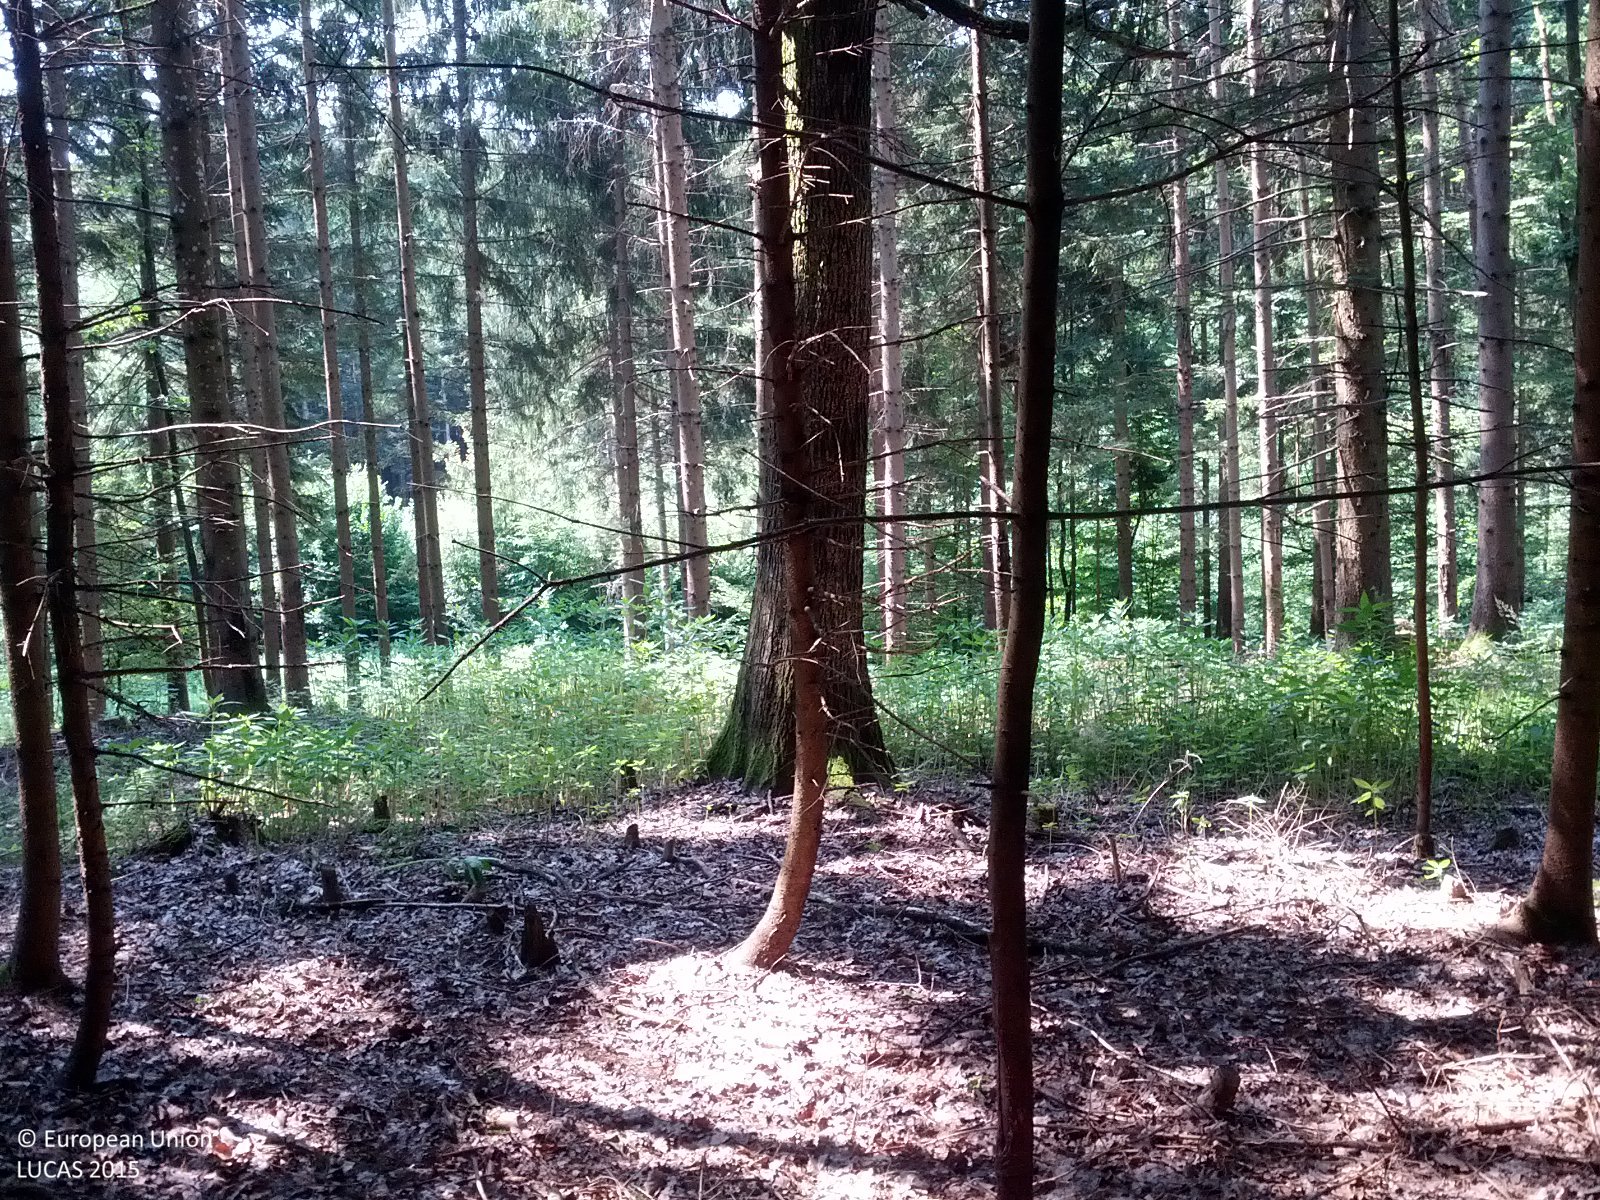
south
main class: Woodland
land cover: Spruce dominated coniferous woodland
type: hemiboreal forest and nemoral coniferous forest and mixed broadleaved-coniferous forest
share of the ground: > 75 %
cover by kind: coniferous forest trees 90 %, herbaceous plants 5 %, unconsolidated bare surface 5 %
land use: Forestry
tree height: > 5 m
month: July
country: AT
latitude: 47.2593
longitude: 16.1206
